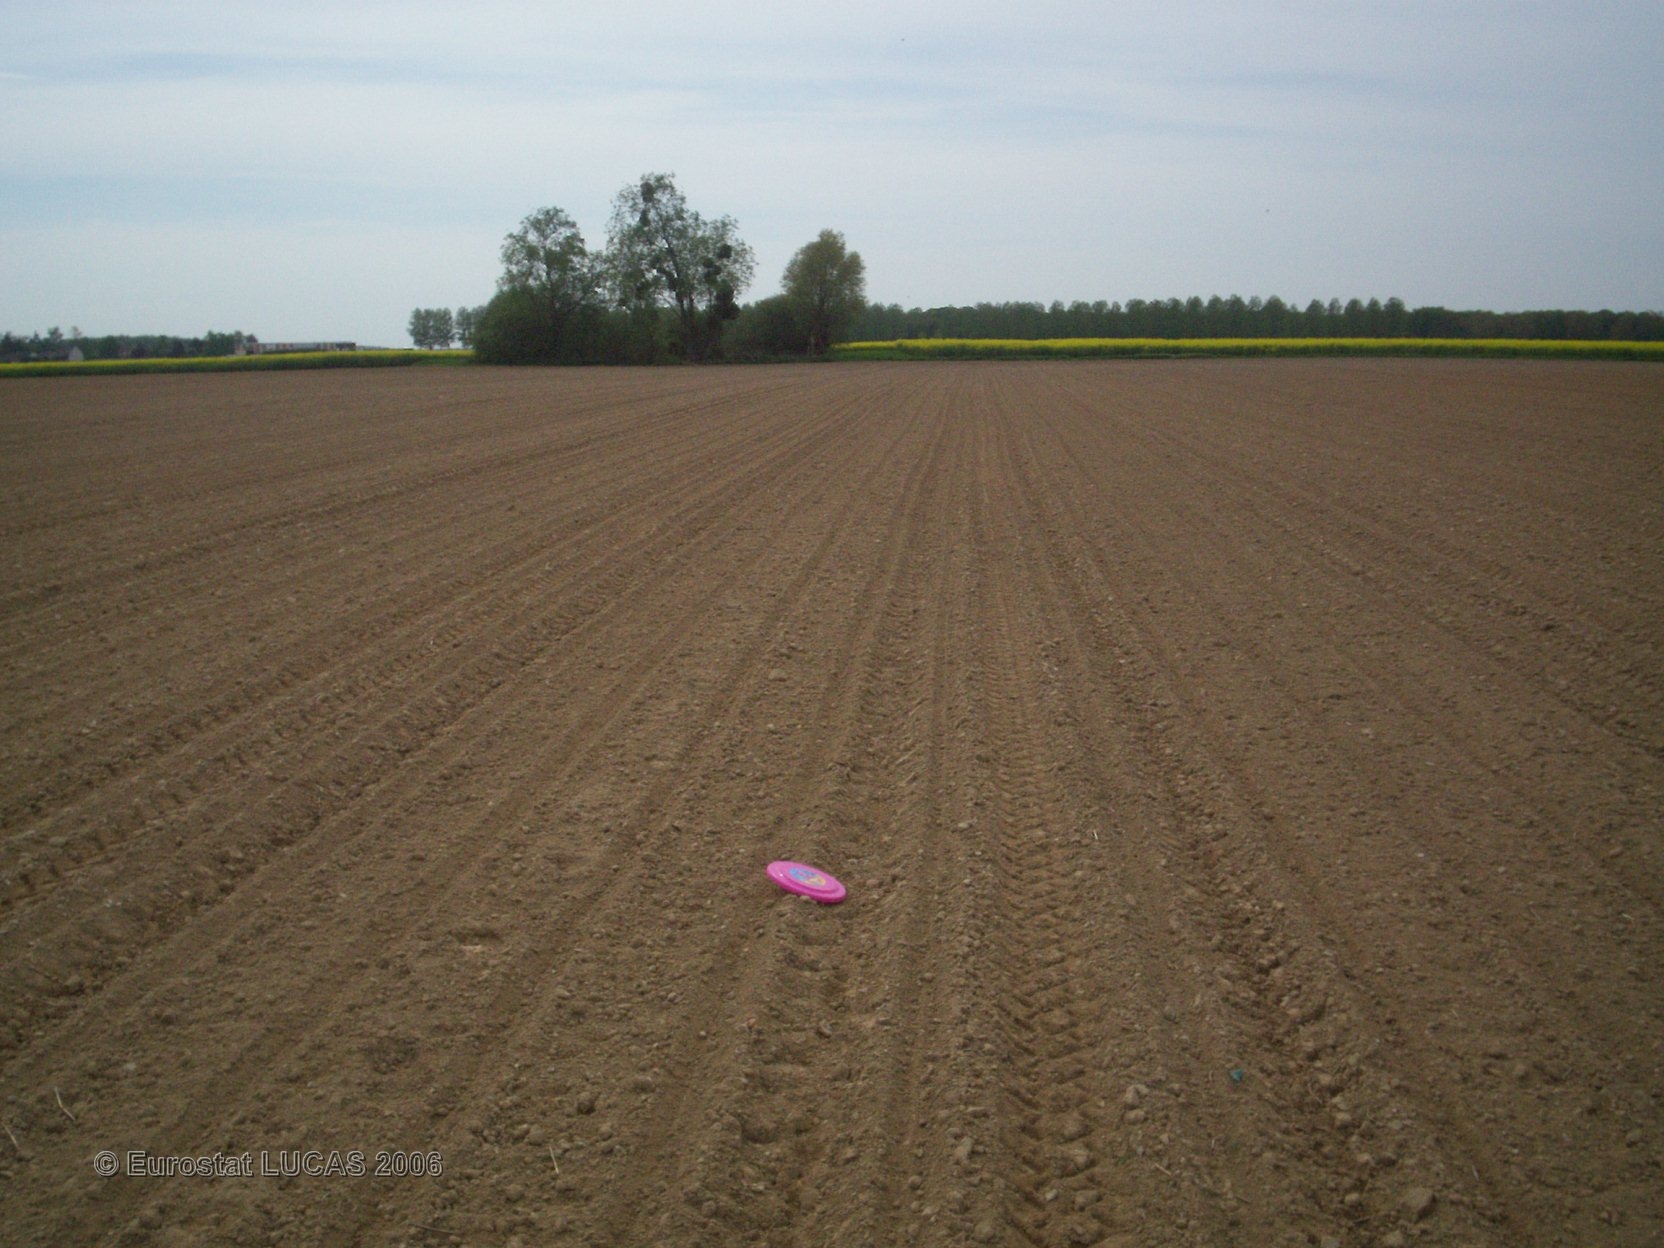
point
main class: Cropland
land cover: Sugar beet
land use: Agriculture (excluding fallow land and kitchen gardens)
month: May
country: FR
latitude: 48.7499
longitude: 2.8503
